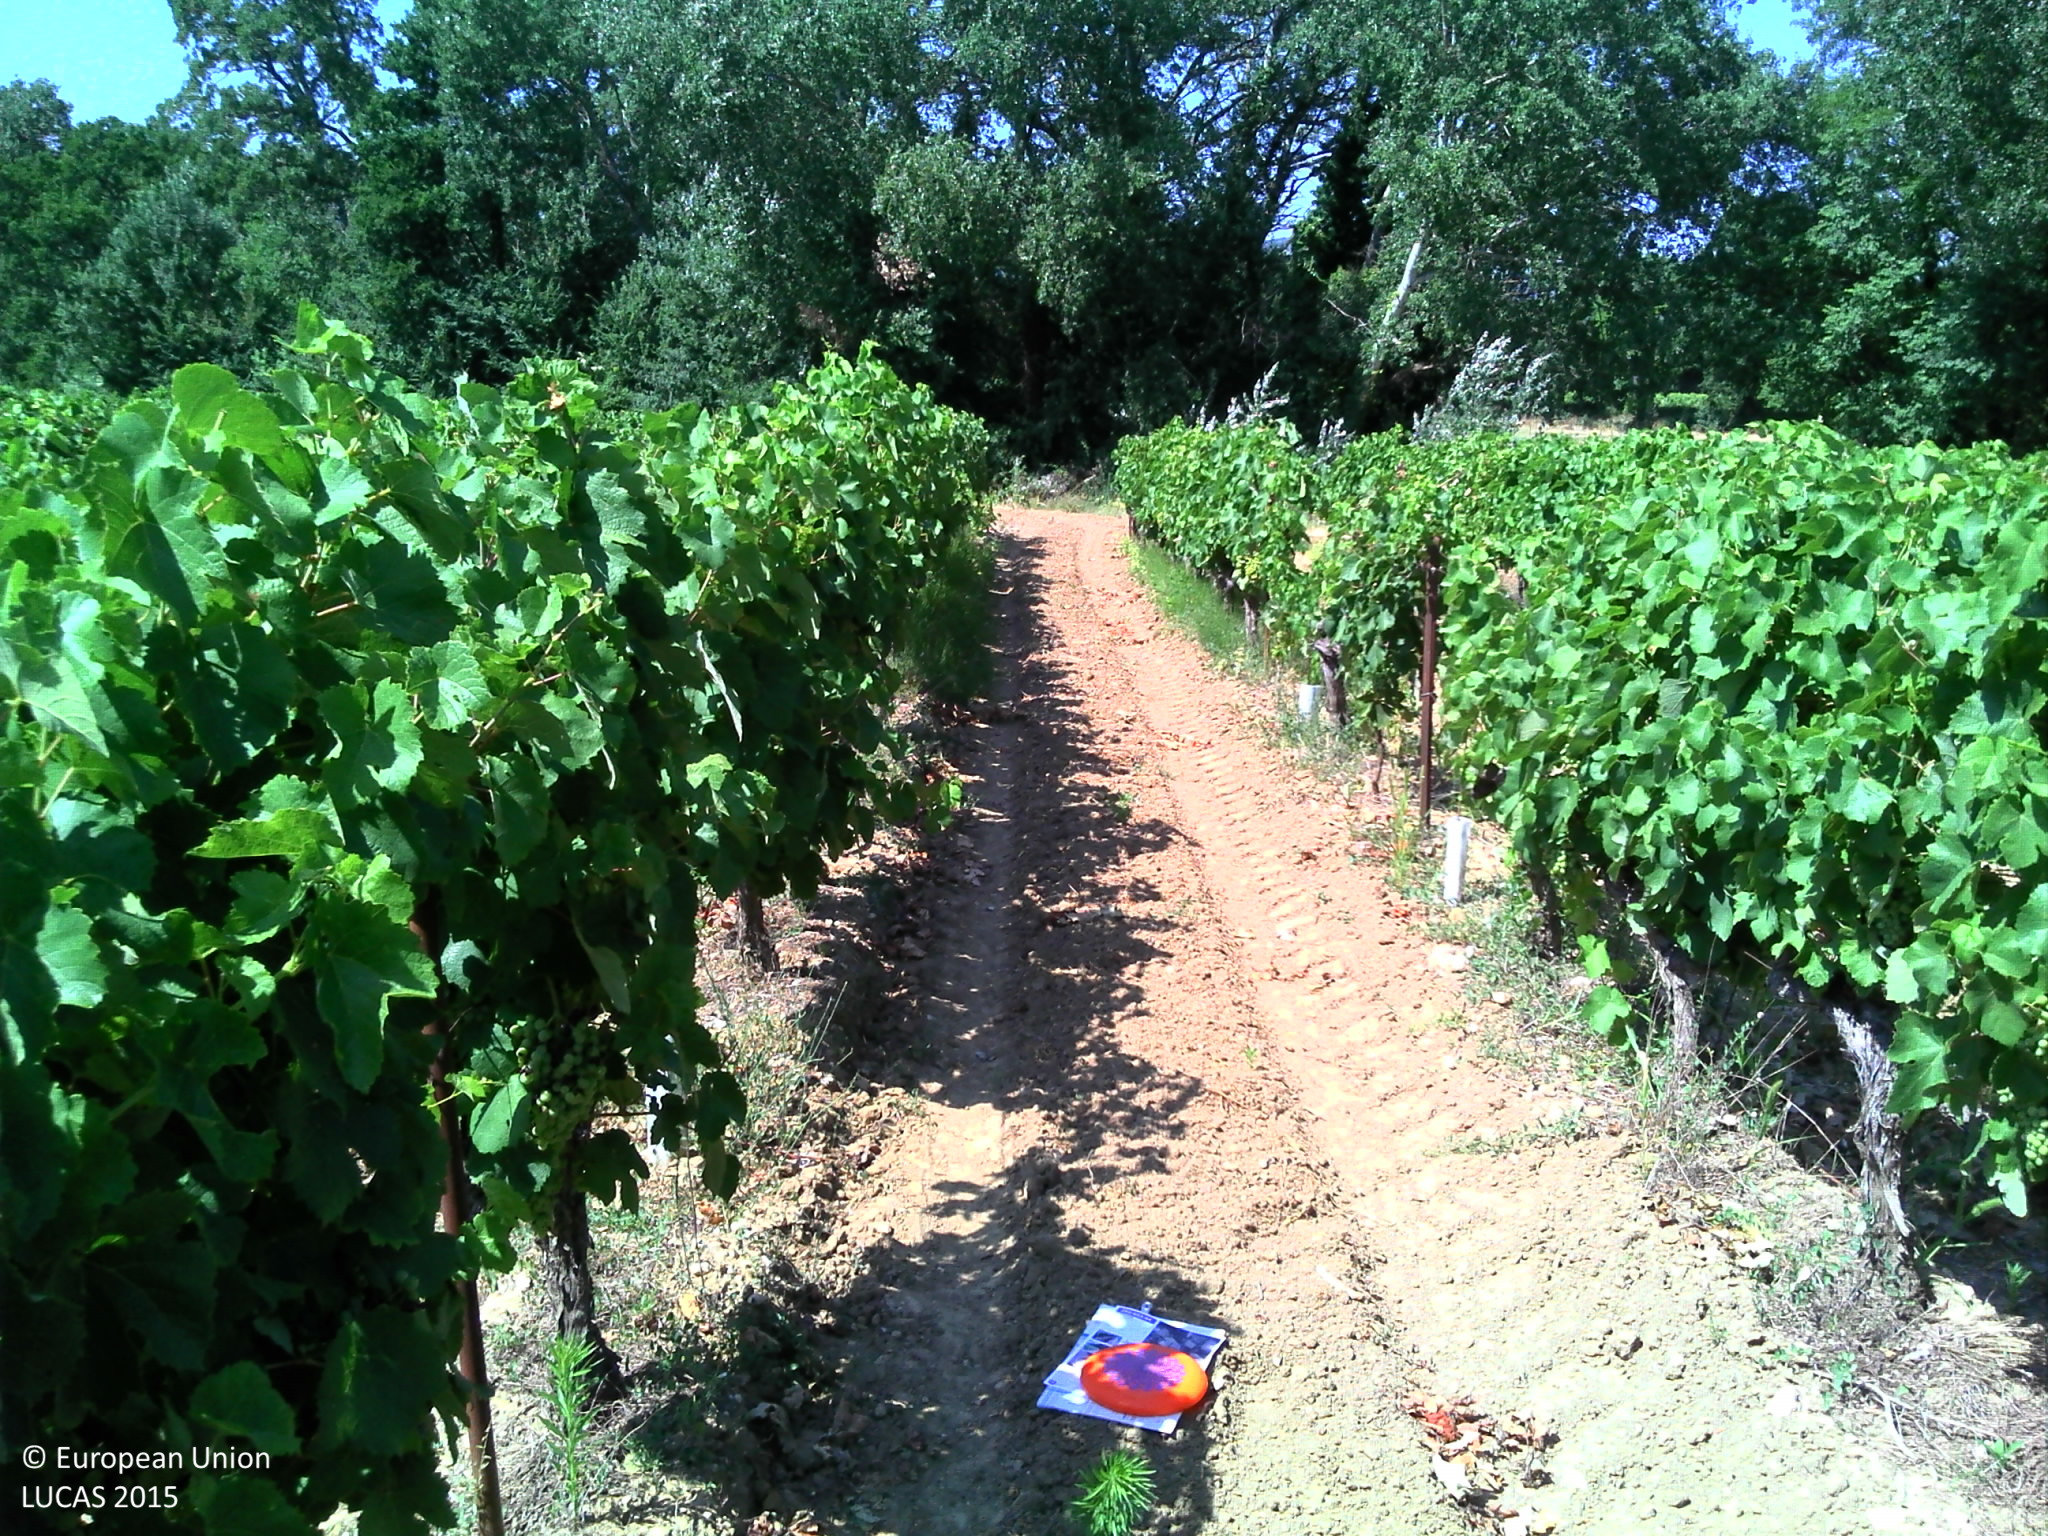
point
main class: Cropland
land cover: Vineyards
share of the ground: 25 - 50 %
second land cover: Other bare soil
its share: > 75 %
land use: Agriculture (excluding fallow land and kitchen gardens)
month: July
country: FR
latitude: 44.0879
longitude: 5.0499
